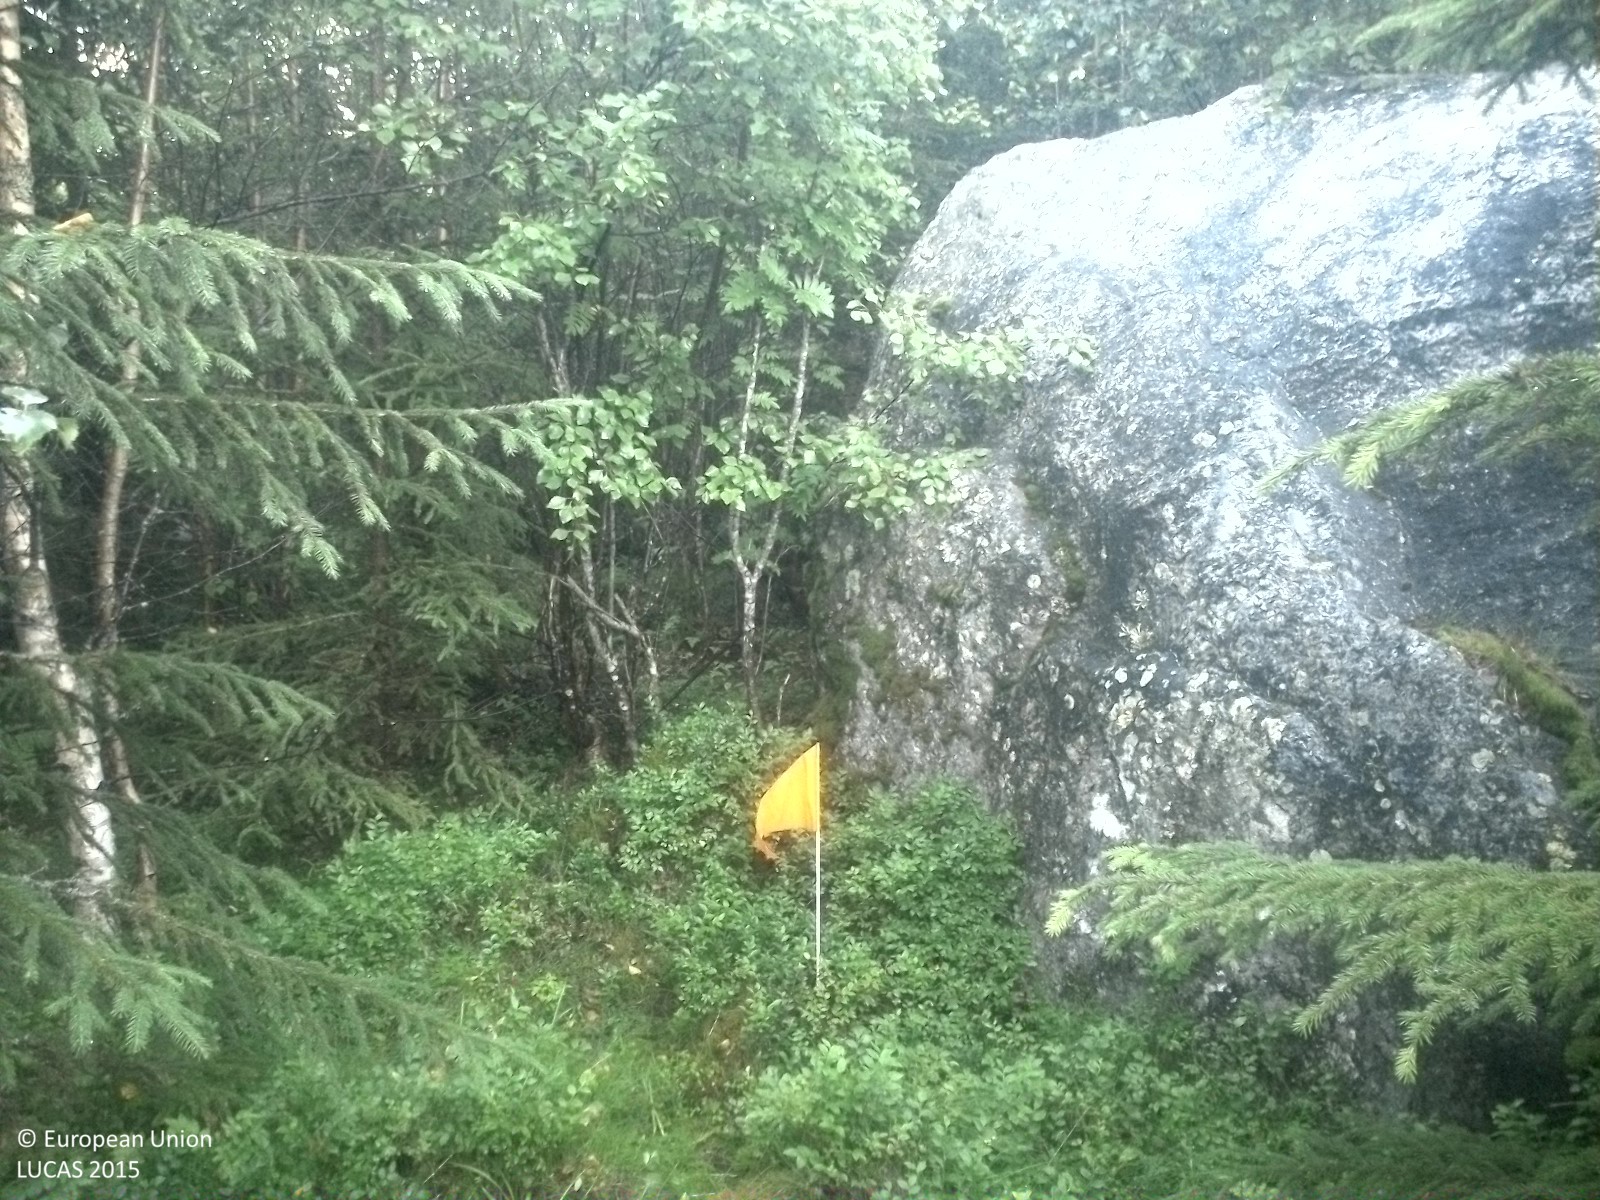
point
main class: Woodland
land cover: Spruce dominated mixed woodland
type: boreal forest
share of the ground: > 75 %
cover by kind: coniferous forest trees 45 %, broadleaved forest trees 30 %, herbaceous plants 25 %
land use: Forestry
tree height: > 5 m
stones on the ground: < 10 %
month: August
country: SE
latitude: 62.6173
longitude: 16.8973
